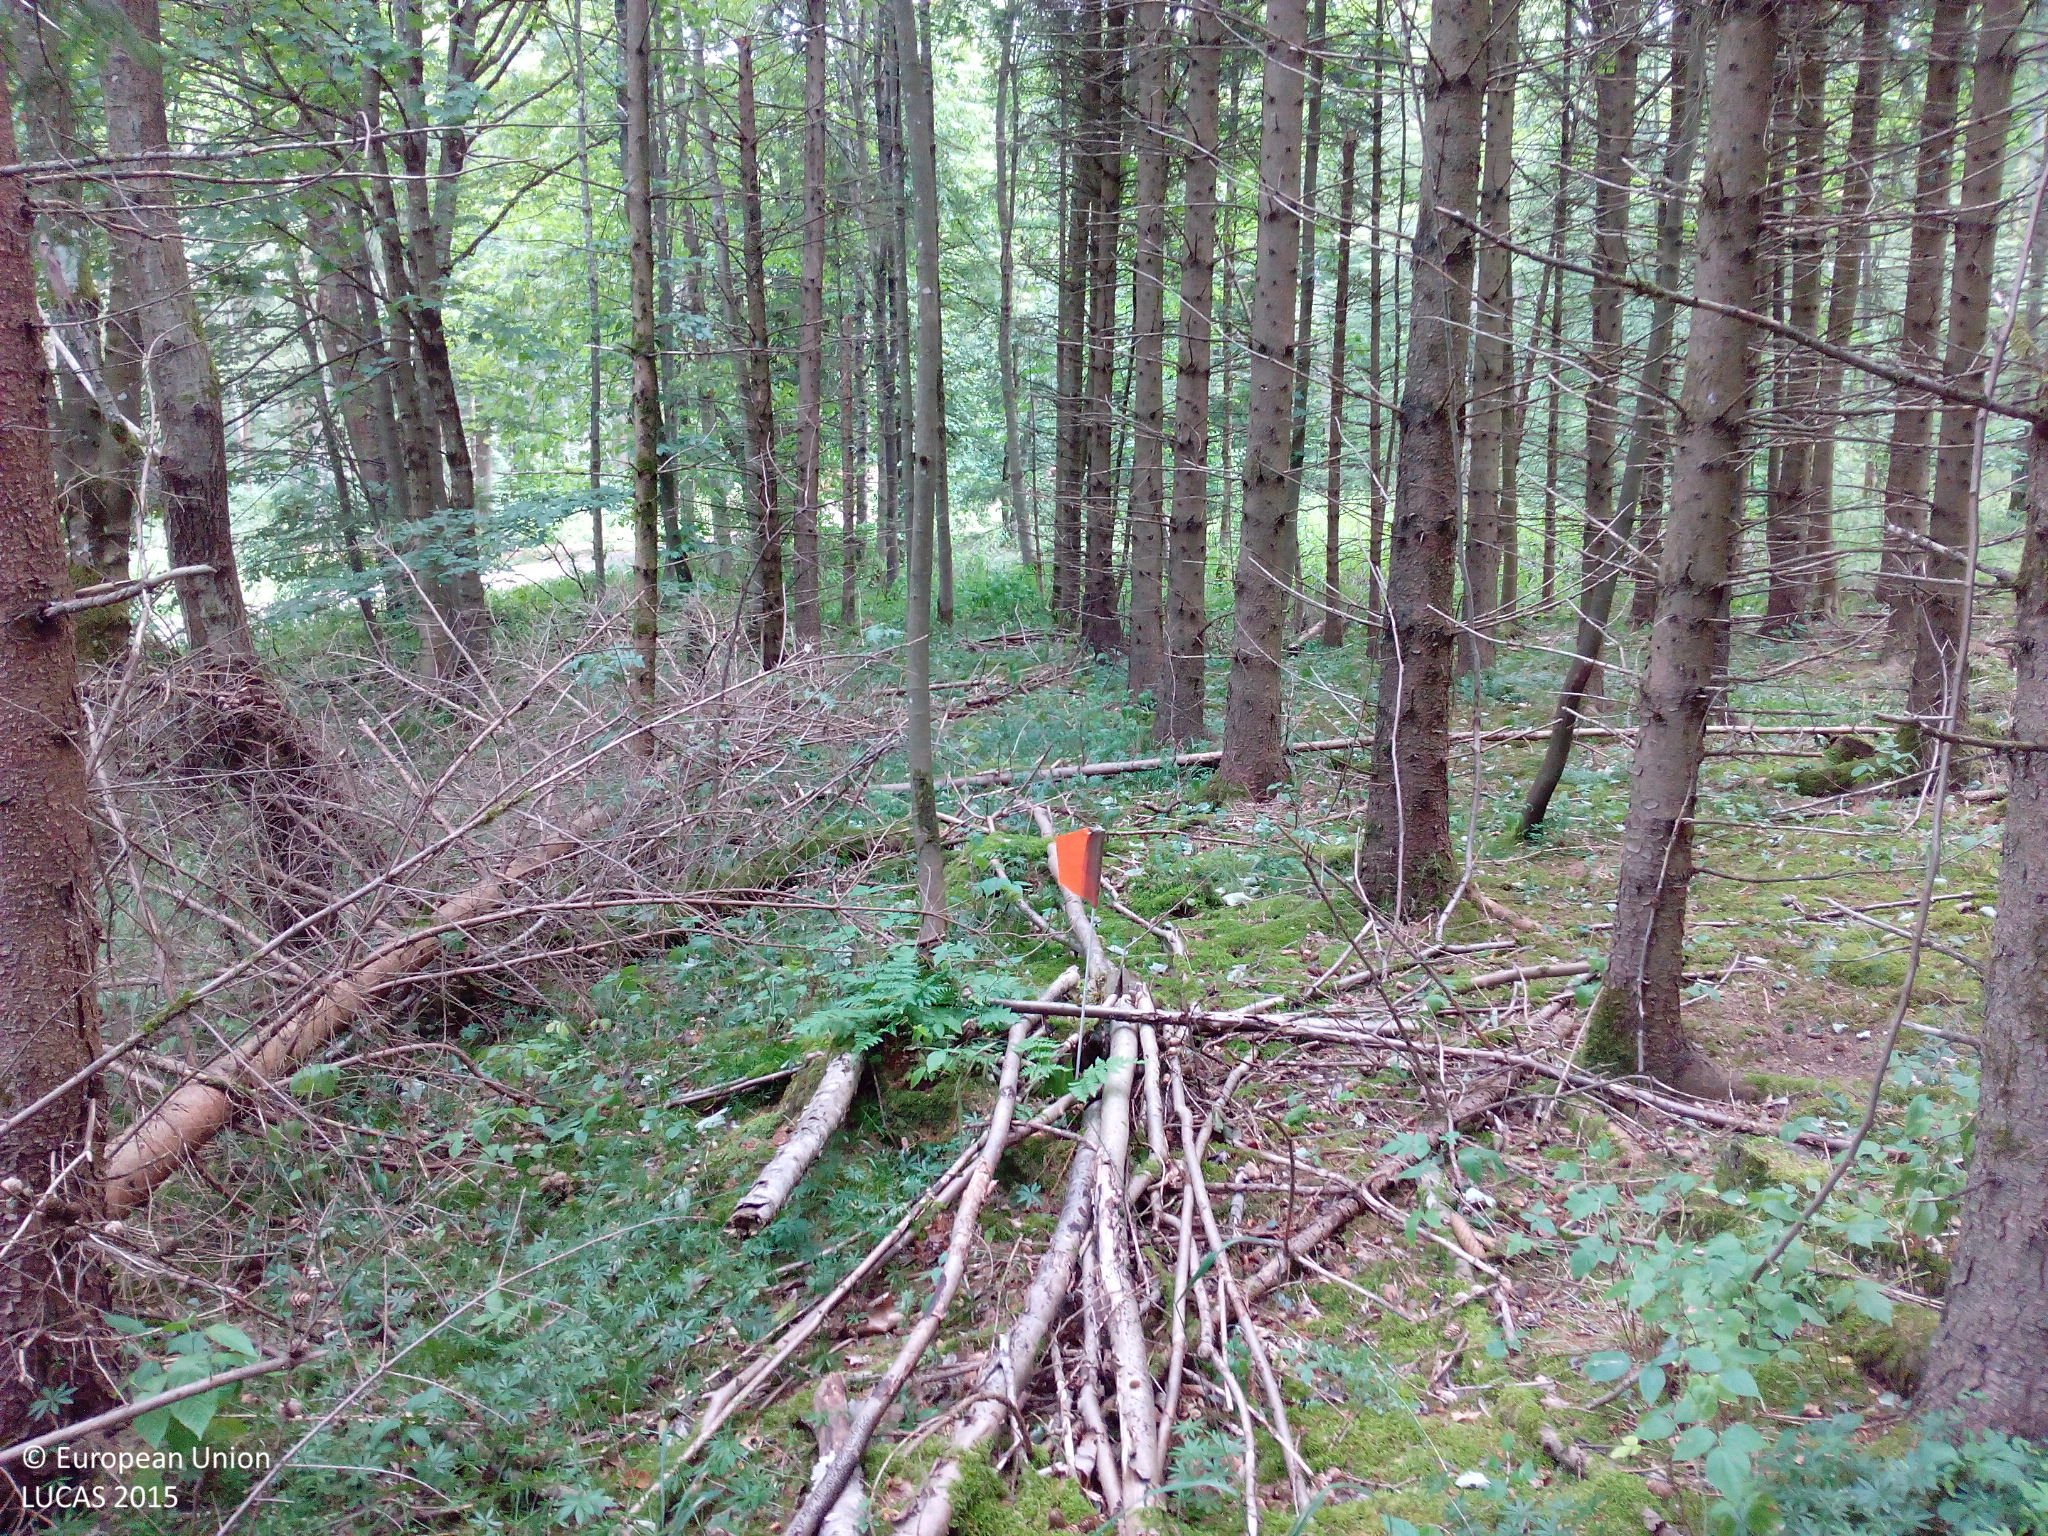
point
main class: Woodland
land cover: Spruce dominated mixed woodland
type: hemiboreal forest and nemoral coniferous forest and mixed broadleaved-coniferous forest
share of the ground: > 75 %
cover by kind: coniferous forest trees 45 %, broadleaved forest trees 30 %, lichens and mosses 15 %, shrubs 5 %, herbaceous plants 5 %
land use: Forestry
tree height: > 5 m
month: July
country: DE
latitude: 48.8169
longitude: 10.3131
